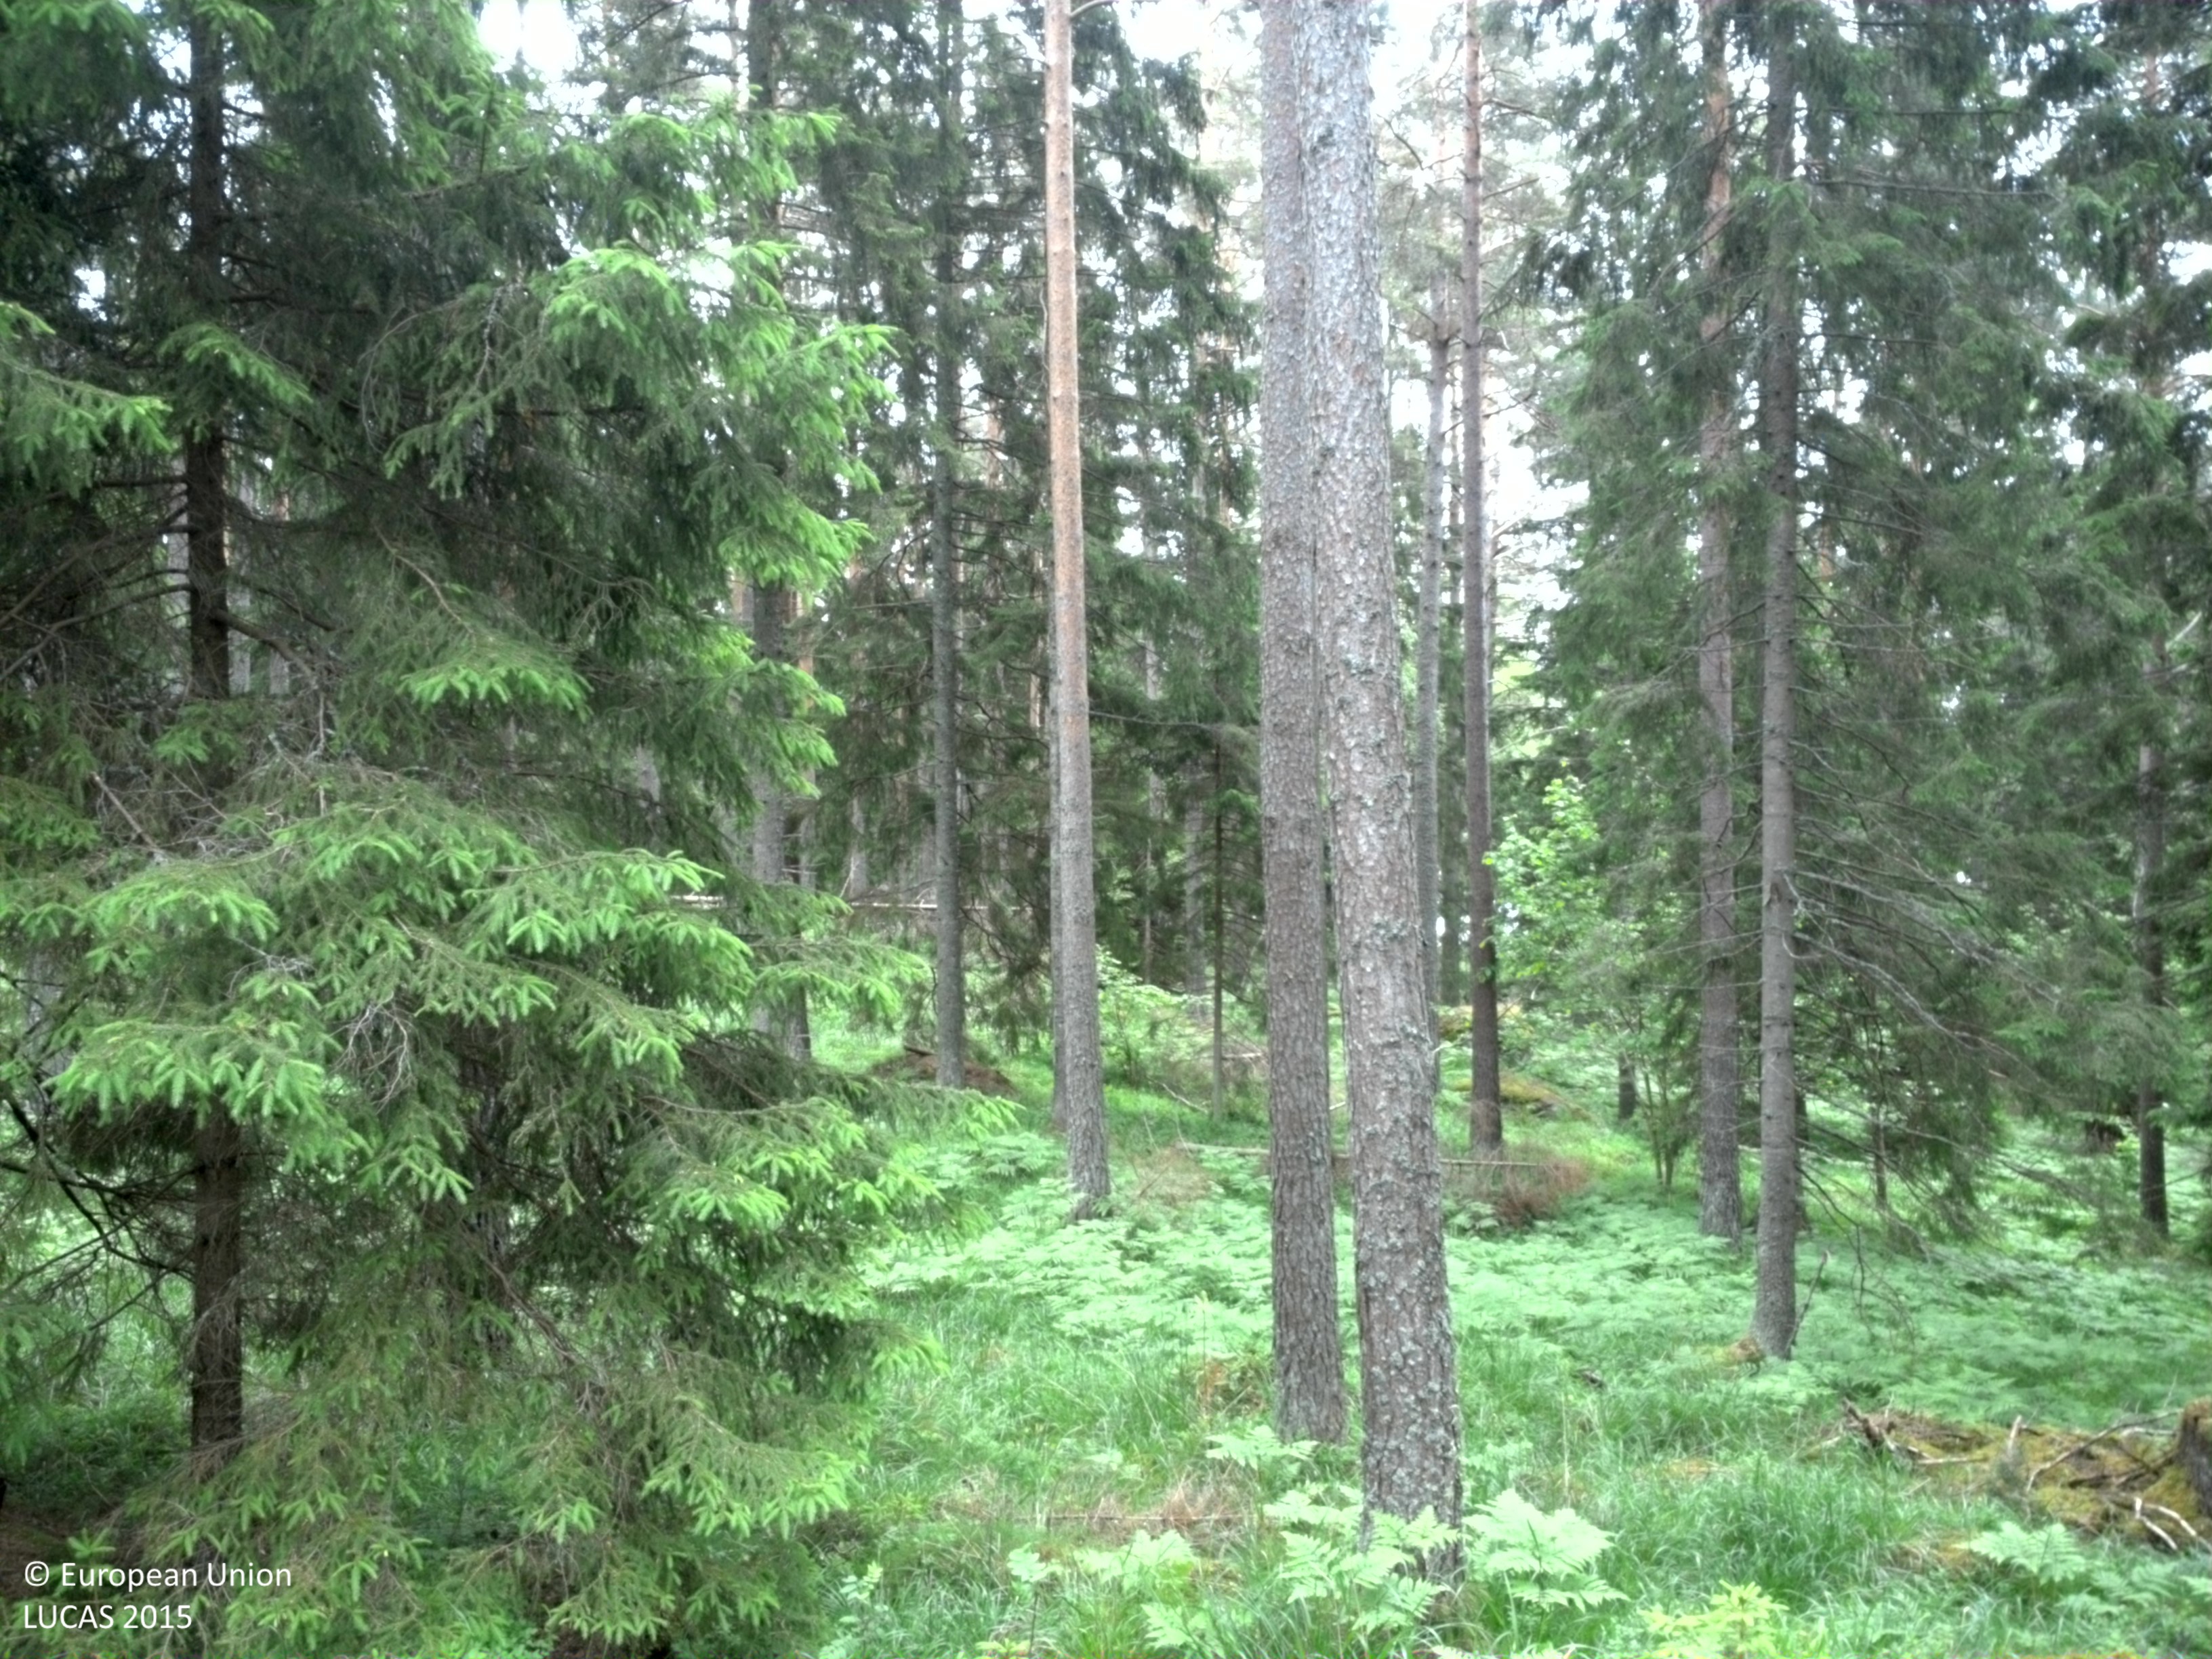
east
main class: Woodland
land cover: Other coniferous woodland
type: boreal forest
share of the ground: 50 - 75 %
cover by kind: coniferous forest trees 55 %, herbaceous plants 20 %, lichens and mosses 20 %, broadleaved forest trees 5 %
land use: Forestry
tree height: > 5 m
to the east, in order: Other coniferous woodland; Spruce dominated coniferous woodland; Spruce dominated mixed woodland; Inland fresh water bodies
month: June
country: SE
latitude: 59.7105
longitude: 18.7280
